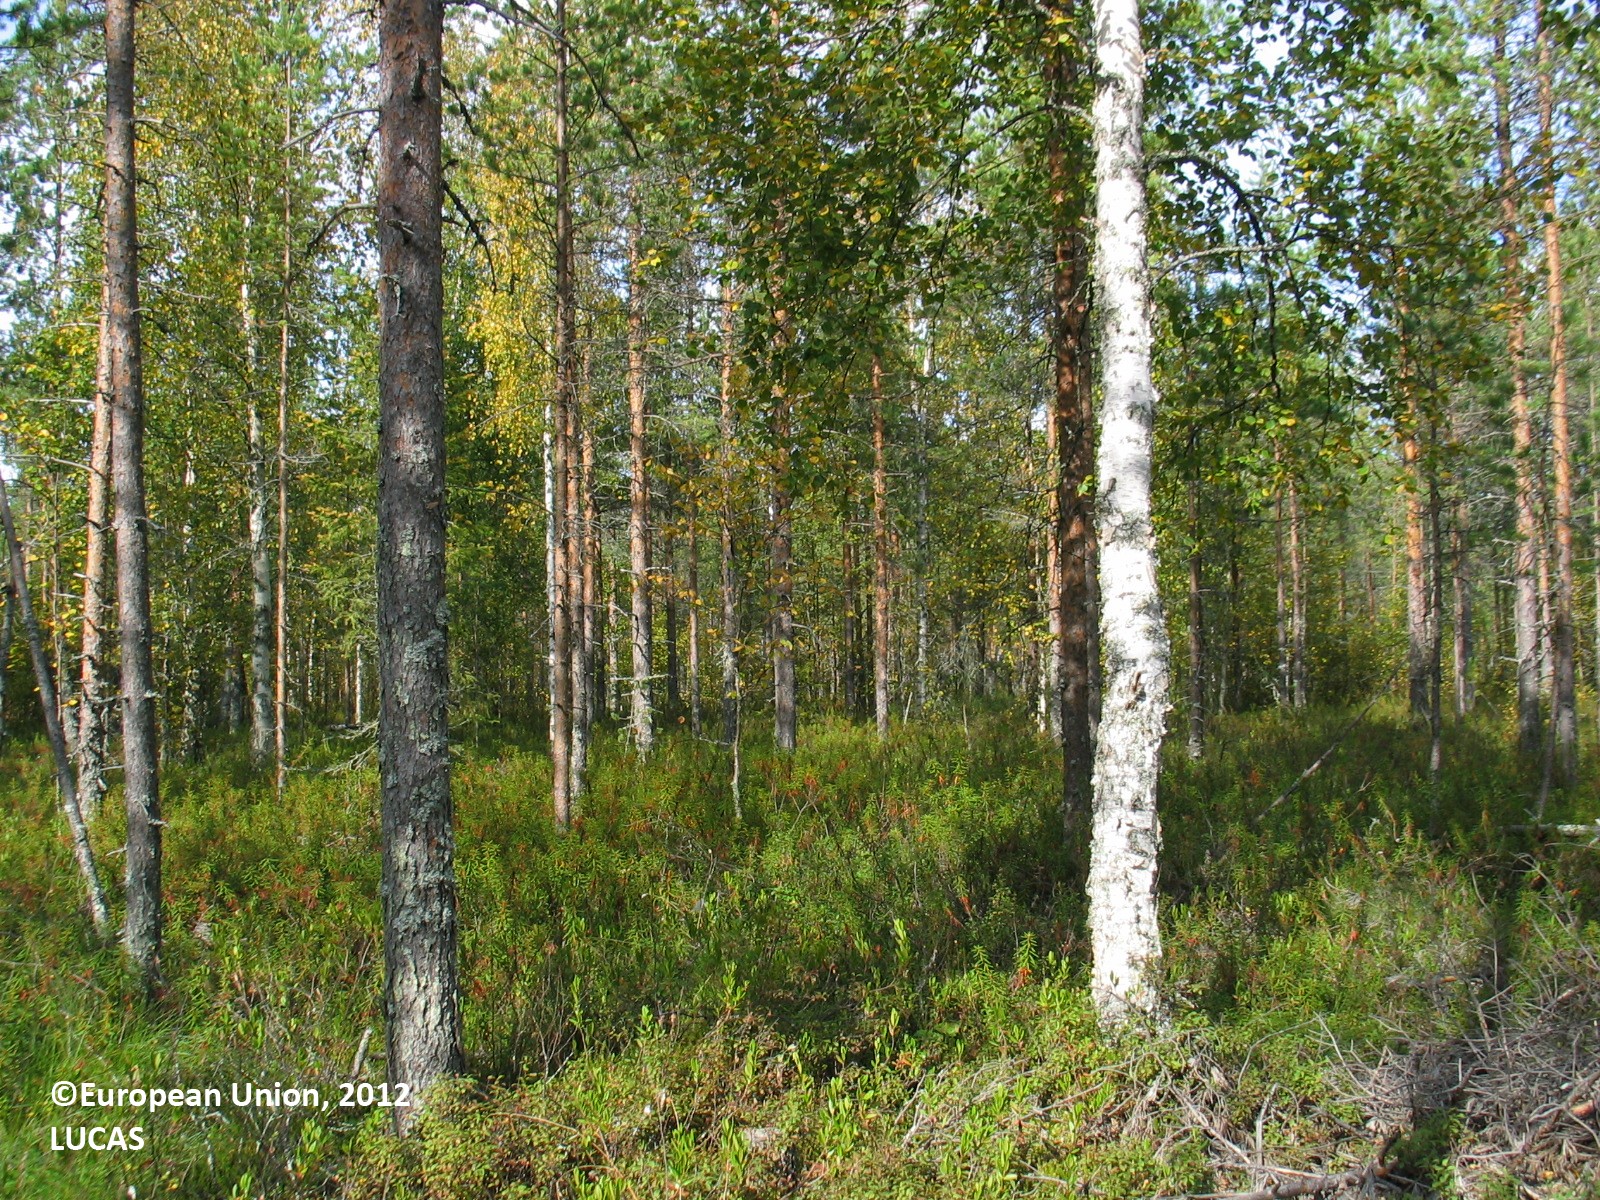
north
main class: Woodland
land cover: Pine dominated coniferous woodland
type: mire and swamp forests
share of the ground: 25 - 50 %
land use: Forestry
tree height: > 5 m
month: August
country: FI
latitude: 65.2394
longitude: 26.4300
